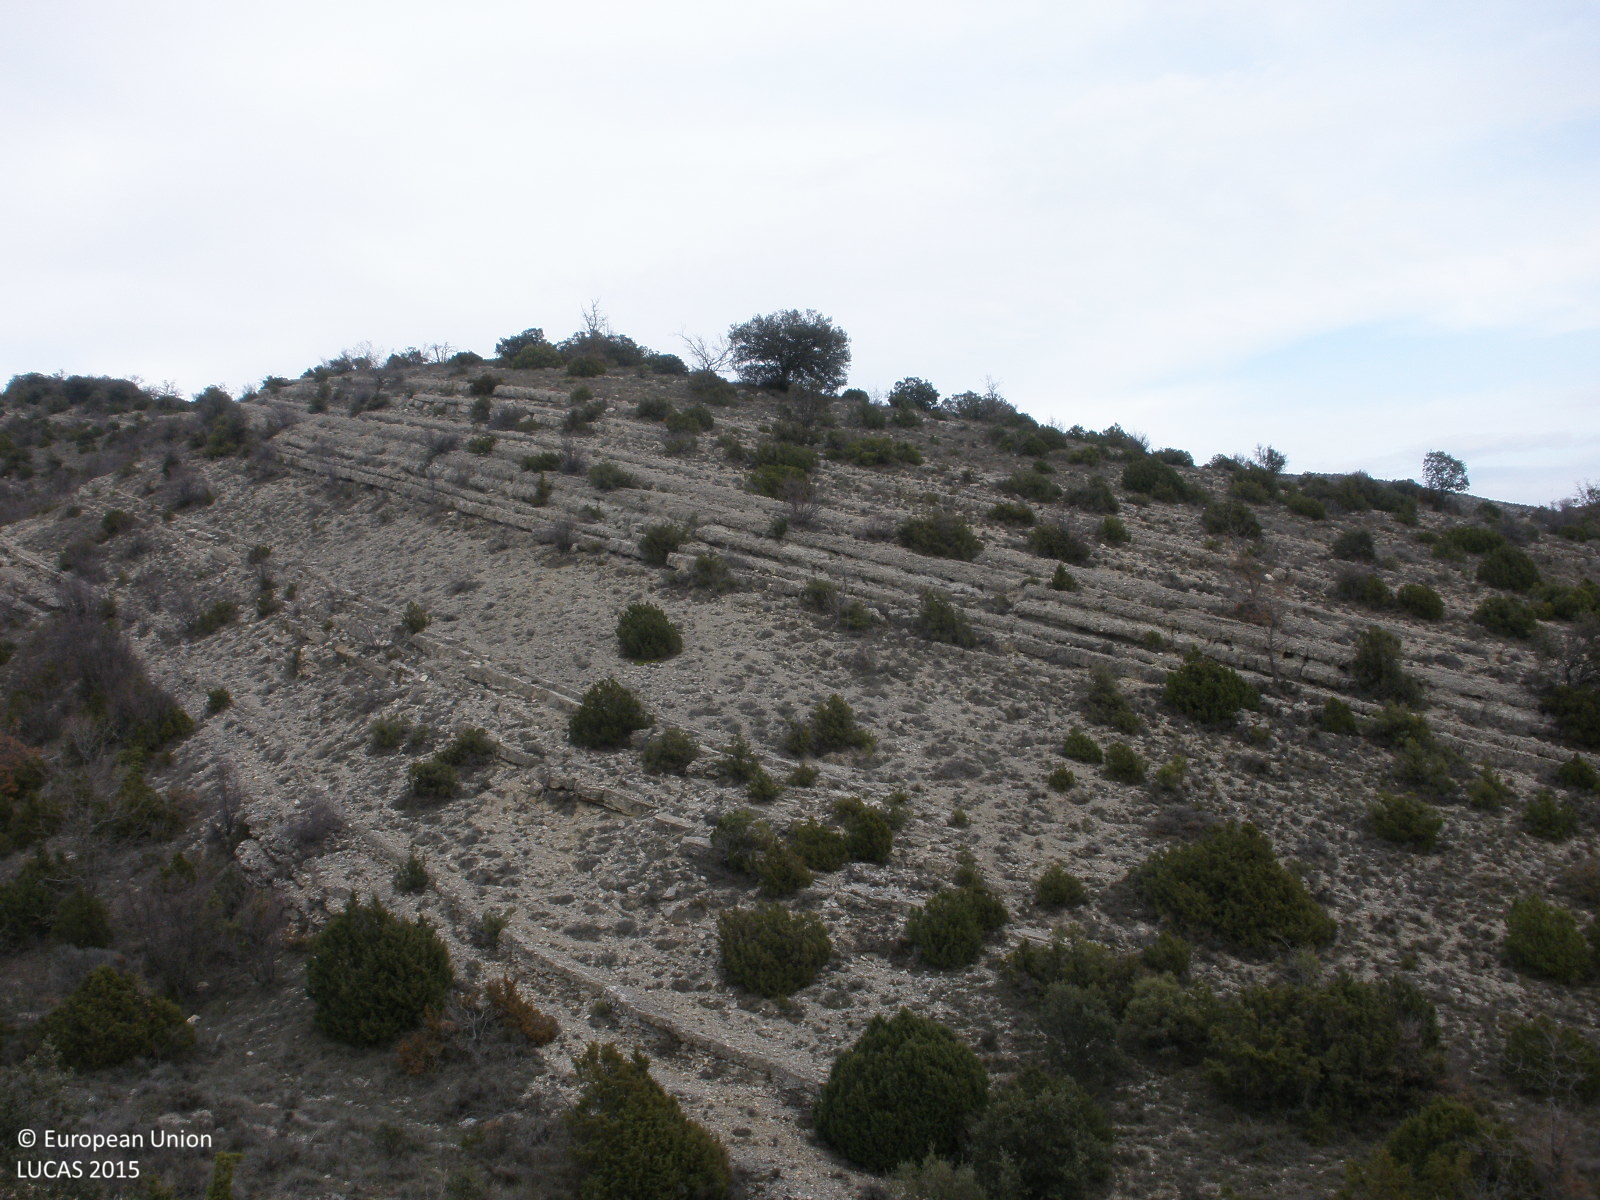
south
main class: Woodland
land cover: Other coniferous woodland
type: coniferous forest of the mediterranean region
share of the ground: > 75 %
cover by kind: shrubs 40 %, coniferous forest trees 30 %, consolidated bare surface 30 %
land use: Semi-natural and natural areas not in use
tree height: < 5 m
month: April
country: ES
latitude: 41.0354
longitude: -1.1396
